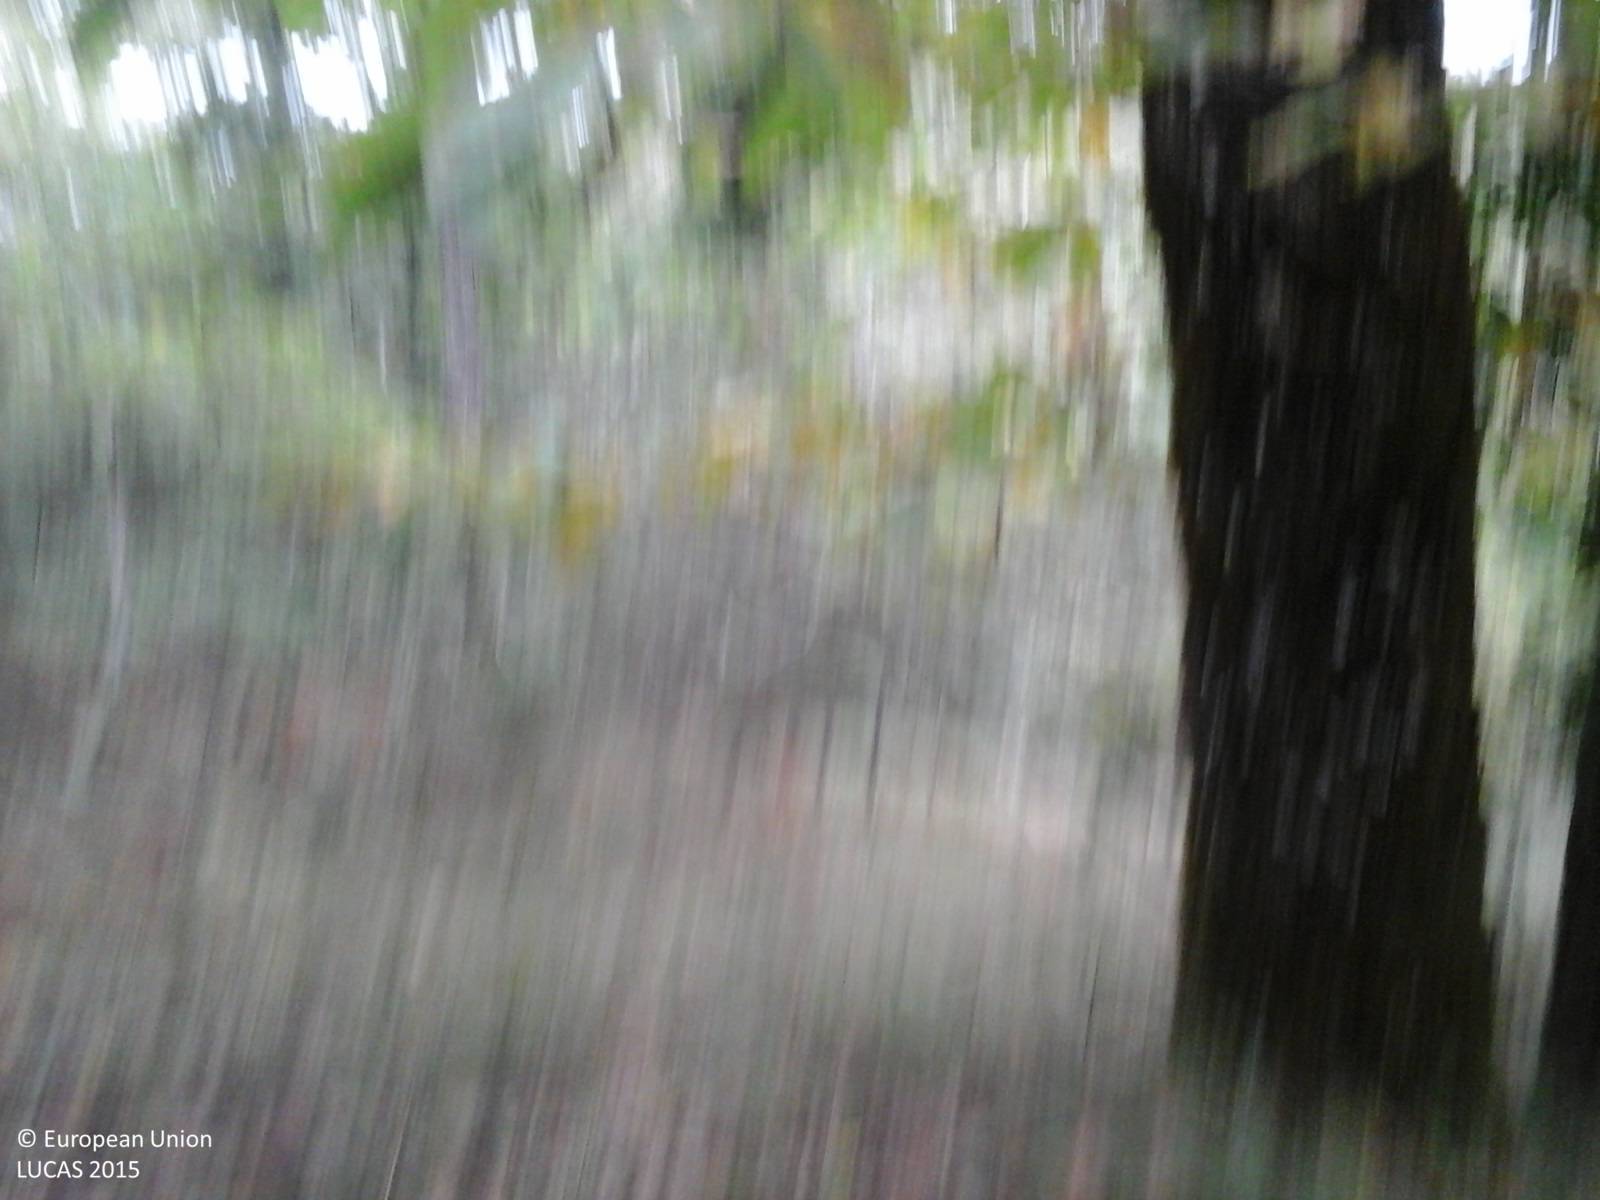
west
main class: Woodland
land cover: Broadleaved woodland
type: thermophilous deciduous forest
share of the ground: > 75 %
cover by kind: broadleaved forest trees 75 %, shrubs 25 %
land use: Forestry
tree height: > 5 m
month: October
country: IT
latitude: 43.3451
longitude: 11.6360
